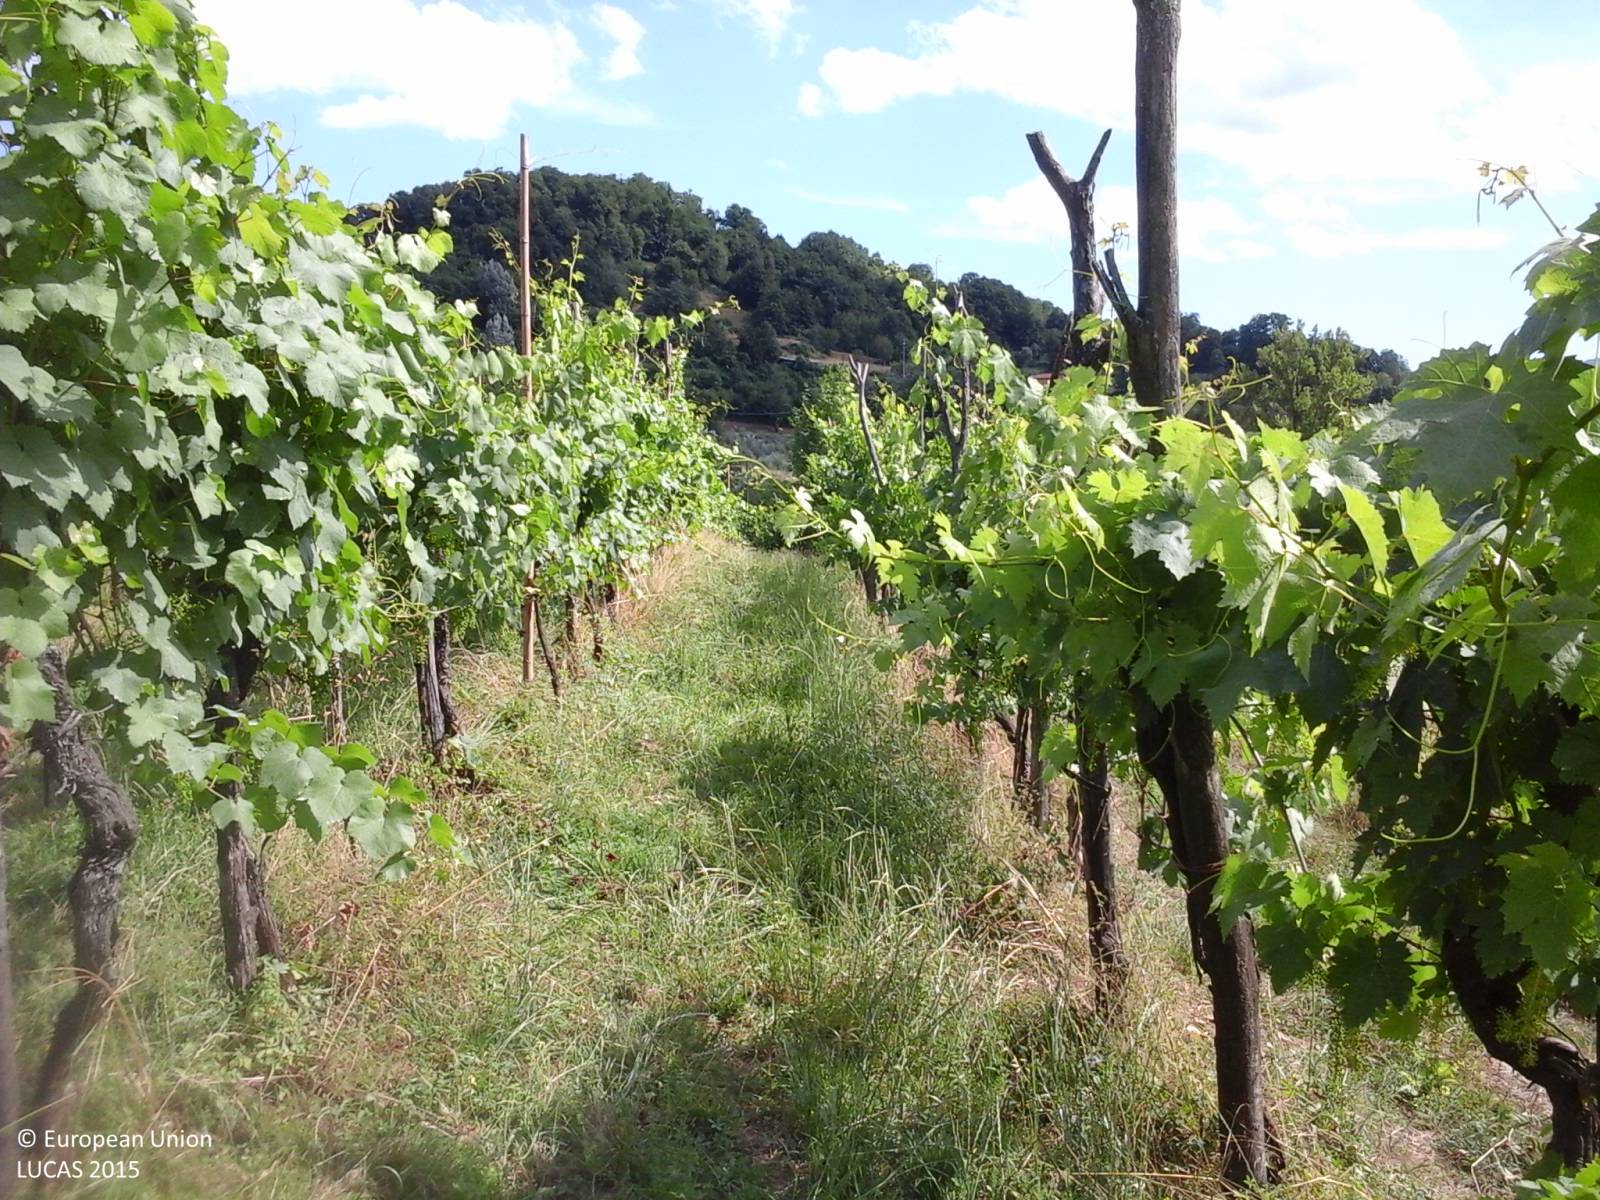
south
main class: Cropland
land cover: Vineyards
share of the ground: 25 - 50 %
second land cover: Grassland without tree/shrub cover
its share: 25 - 50 %
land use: Agriculture (excluding fallow land and kitchen gardens)
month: June
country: IT
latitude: 44.3866
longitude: 9.8873
